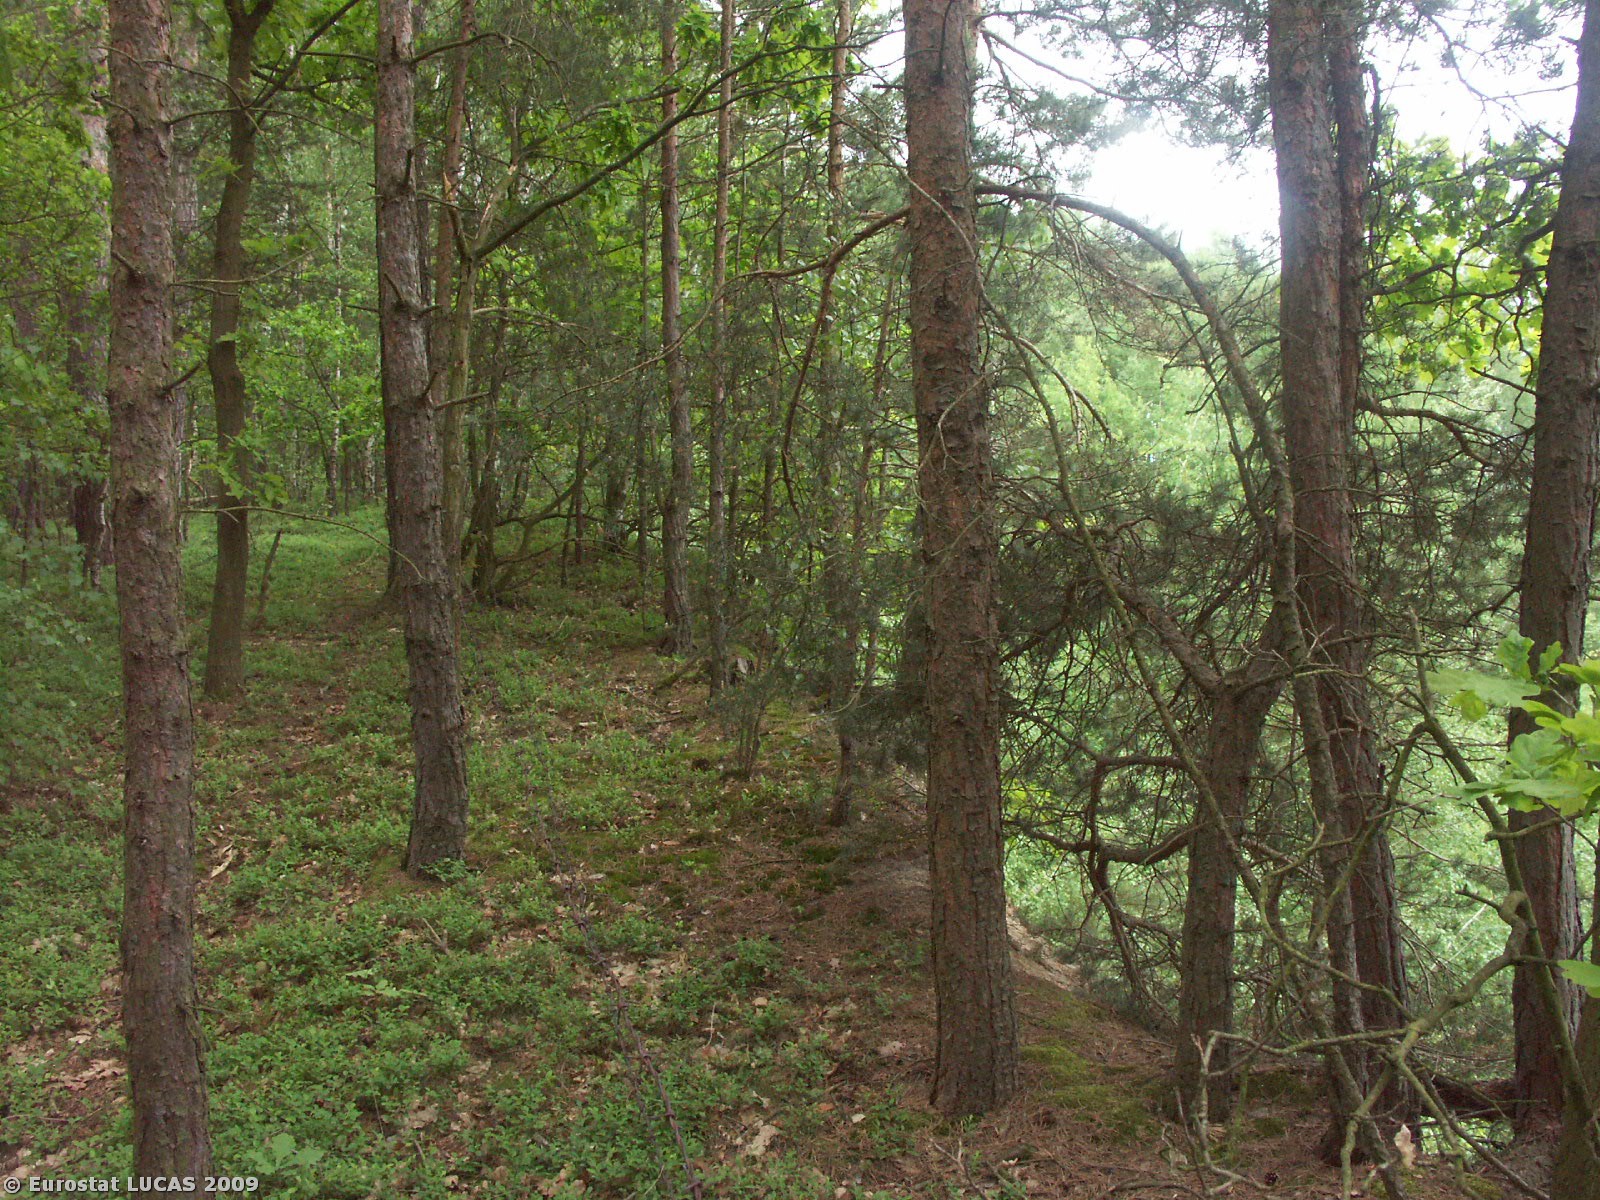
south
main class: Woodland
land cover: Mixed woodland
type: hemiboreal forest and nemoral coniferous forest and mixed broadleaved-coniferous forest
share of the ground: > 75 %
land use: Forestry
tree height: > 5 m
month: May
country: CZ
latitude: 48.8453
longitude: 14.6753
